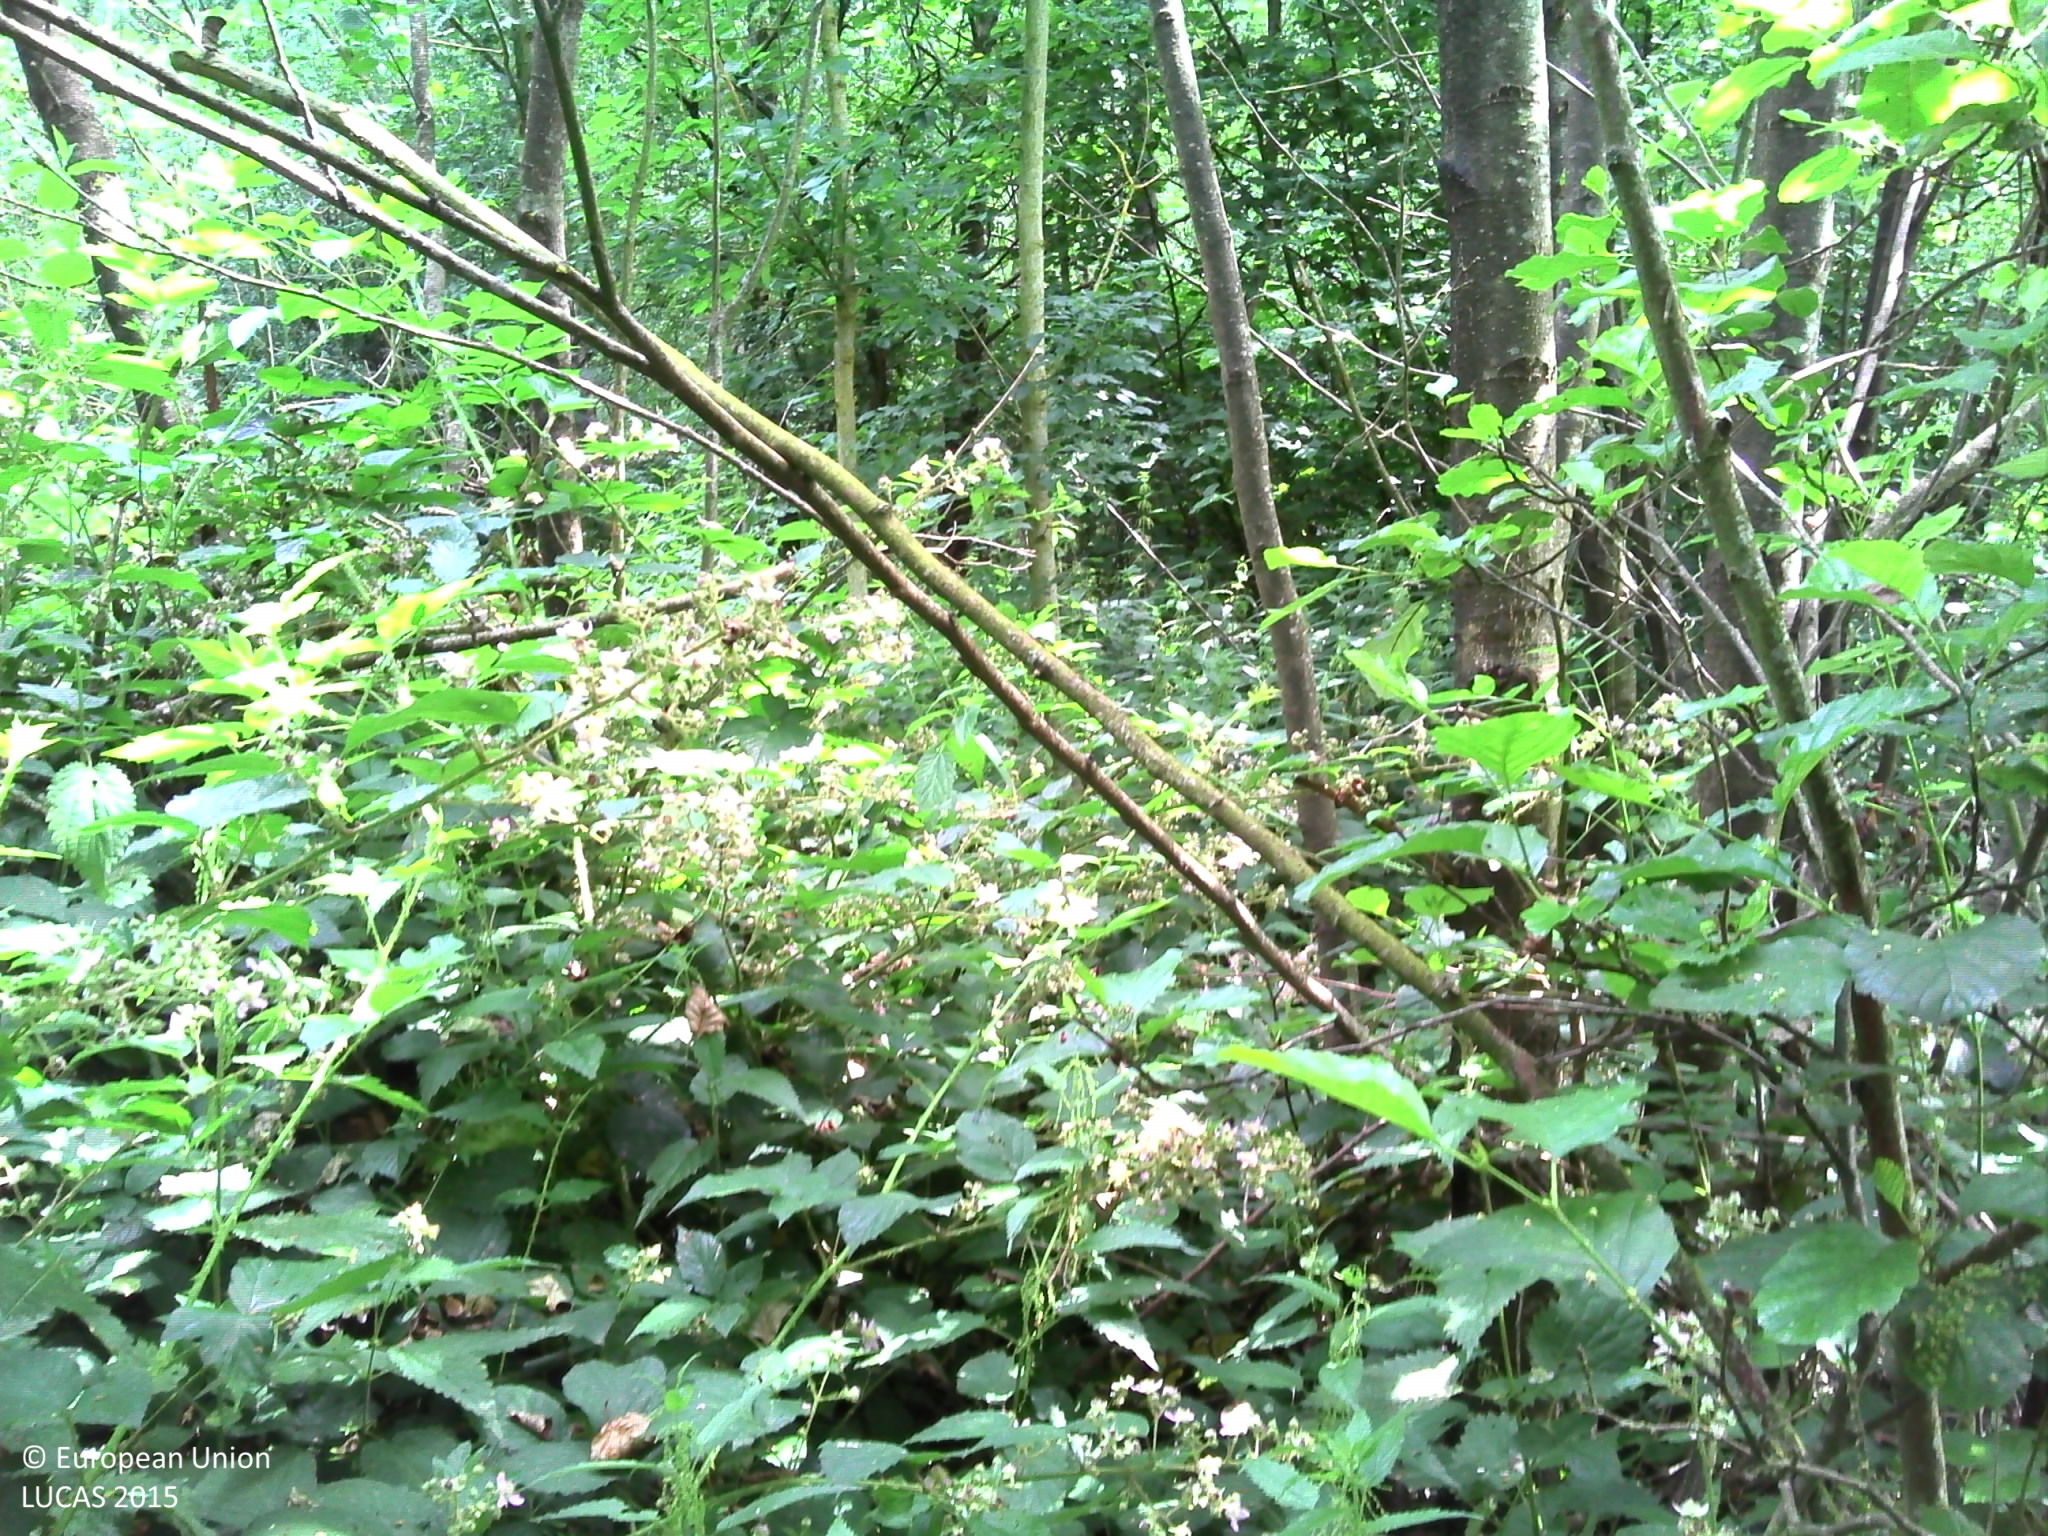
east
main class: Woodland
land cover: Broadleaved woodland
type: floodplain forest
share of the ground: > 75 %
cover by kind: broadleaved forest trees 95 %, herbaceous plants 5 %
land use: Forestry
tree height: > 5 m
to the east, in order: Broadleaved woodland; Rivers and streams; Broadleaved woodland; Rivers and streams; Broadleaved woodland; Fences; Grassland without tree/shrub cover; Fences; Grassland without tree/shrub cover; Fences; Grassland without tree/shrub cover; Fences; Grassland without tree/shrub cover
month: July
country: BE
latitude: 50.2750
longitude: 4.6503
